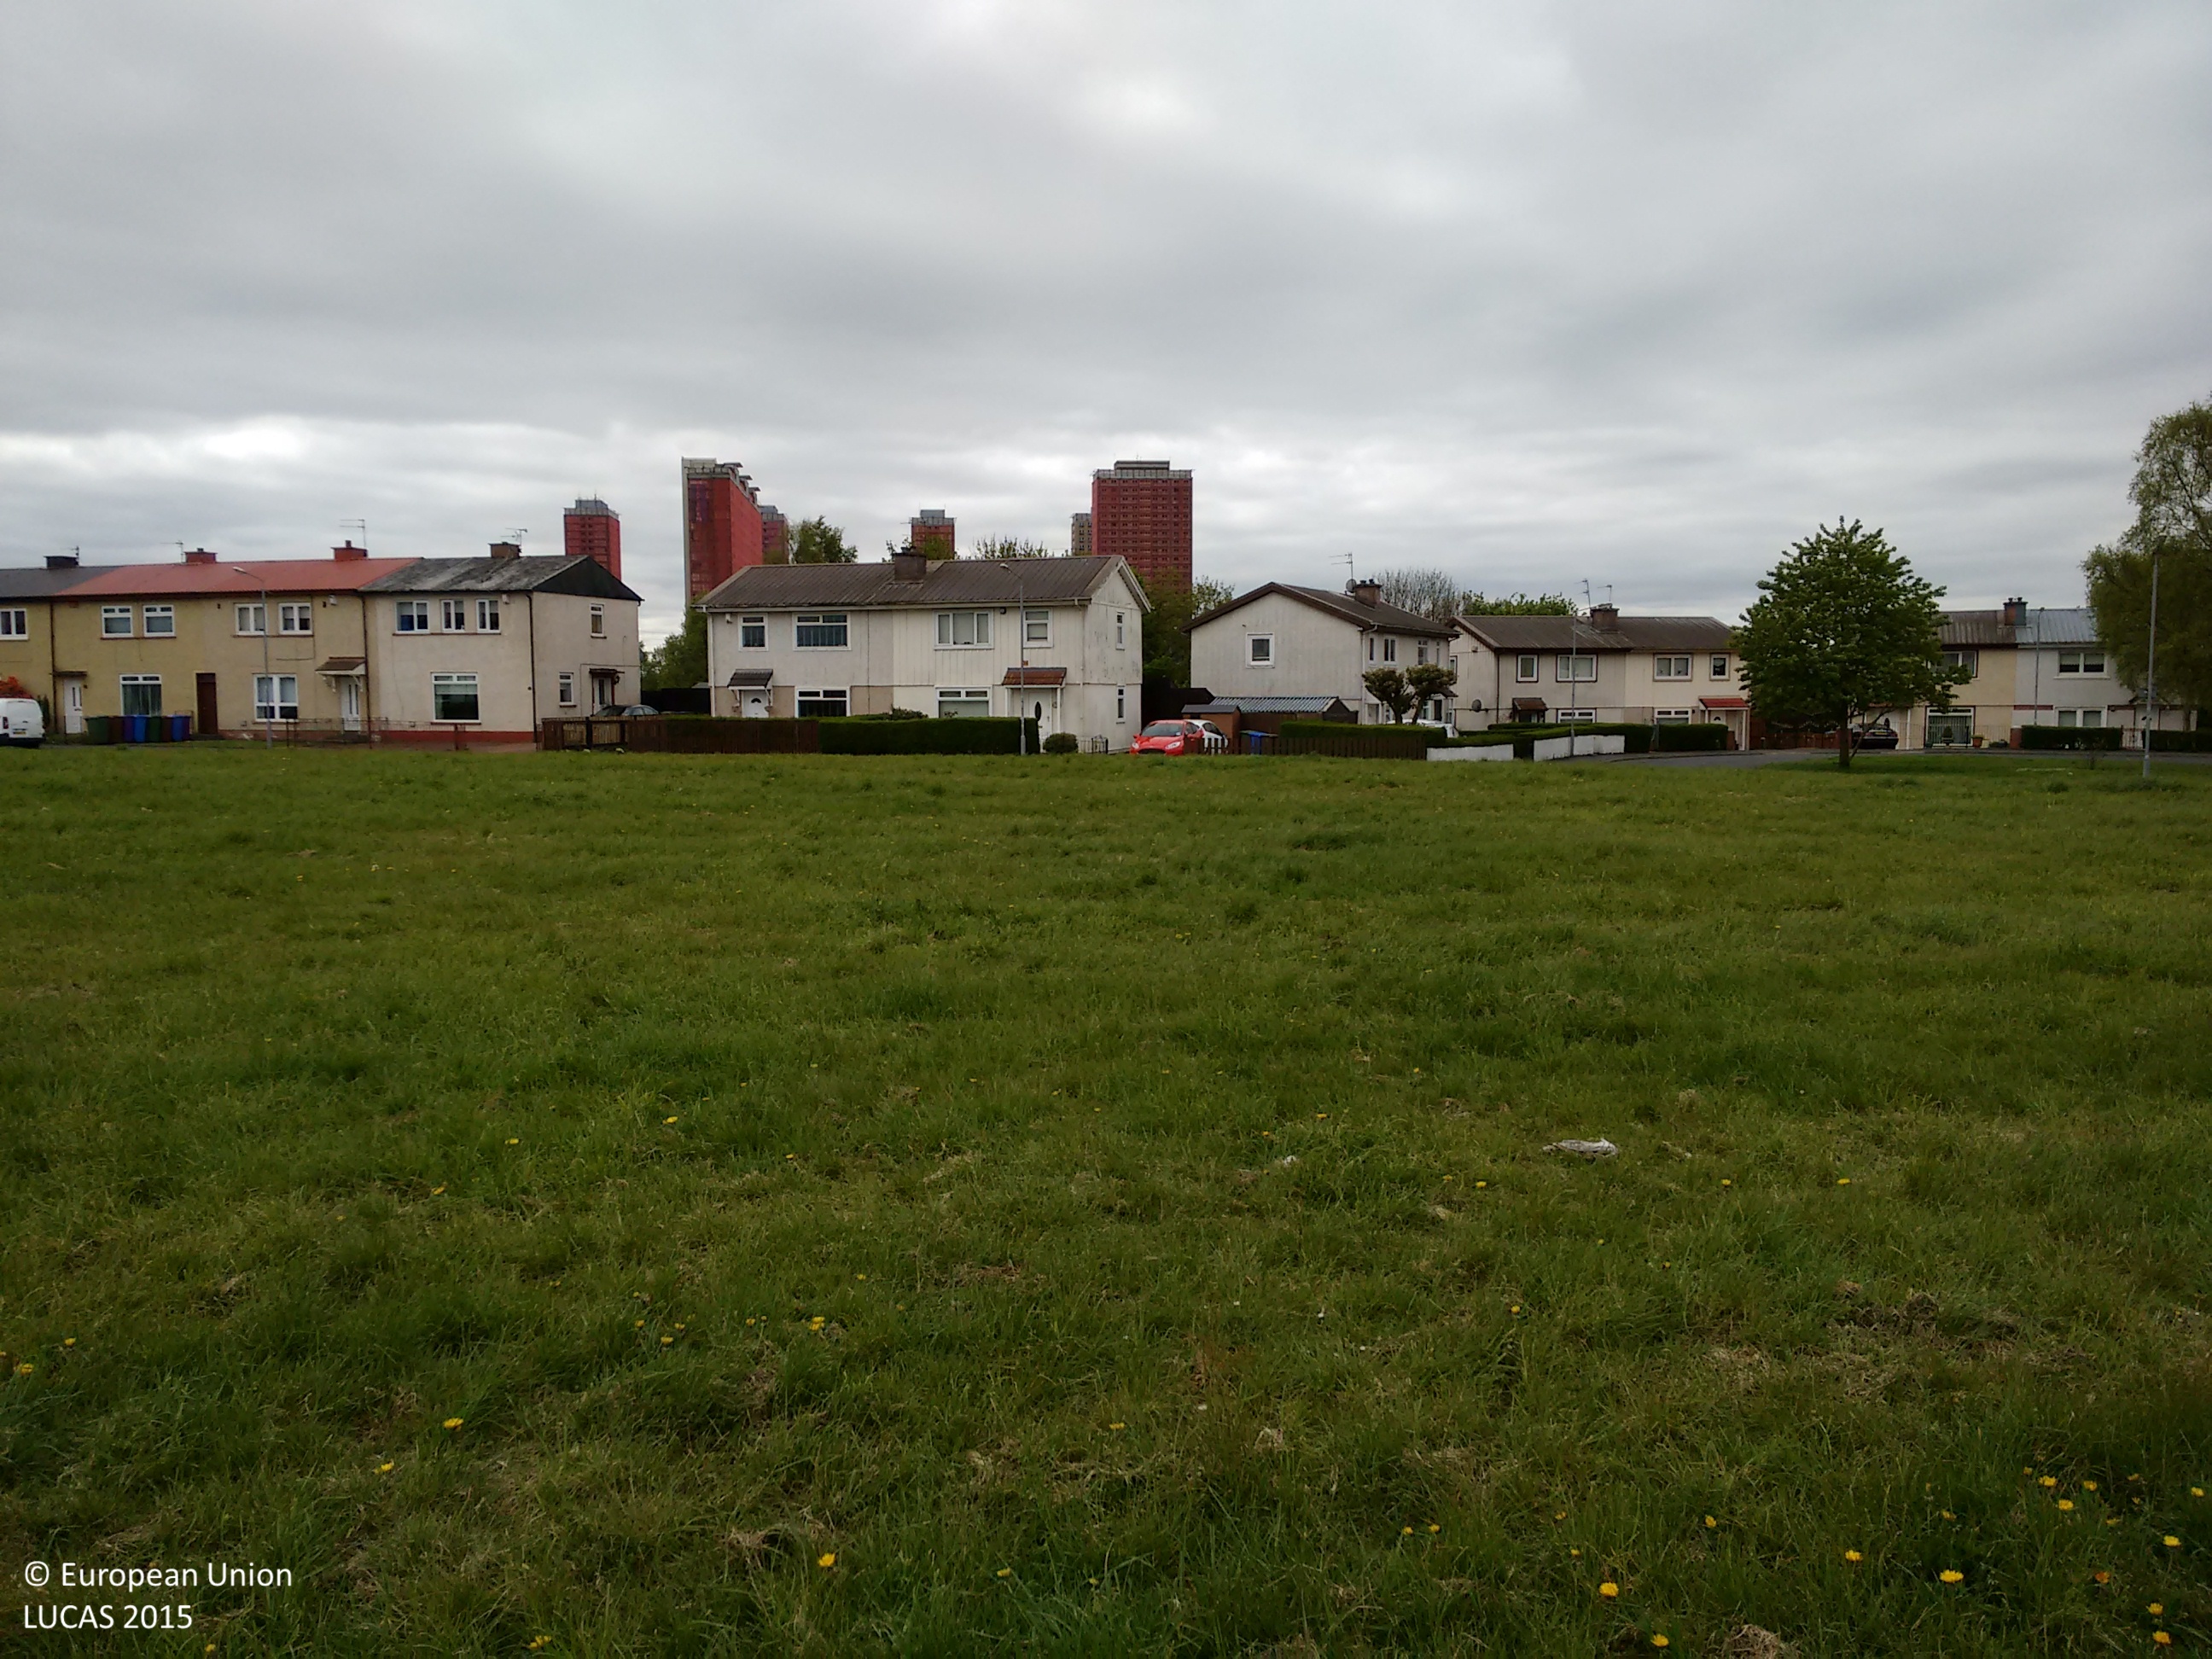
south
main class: Grassland
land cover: Grassland without tree/shrub cover
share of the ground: > 75 %
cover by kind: herbaceous plants 100 %
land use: Amenities, museums, leisure
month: May
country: GB
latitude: 55.8852
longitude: -4.2090
